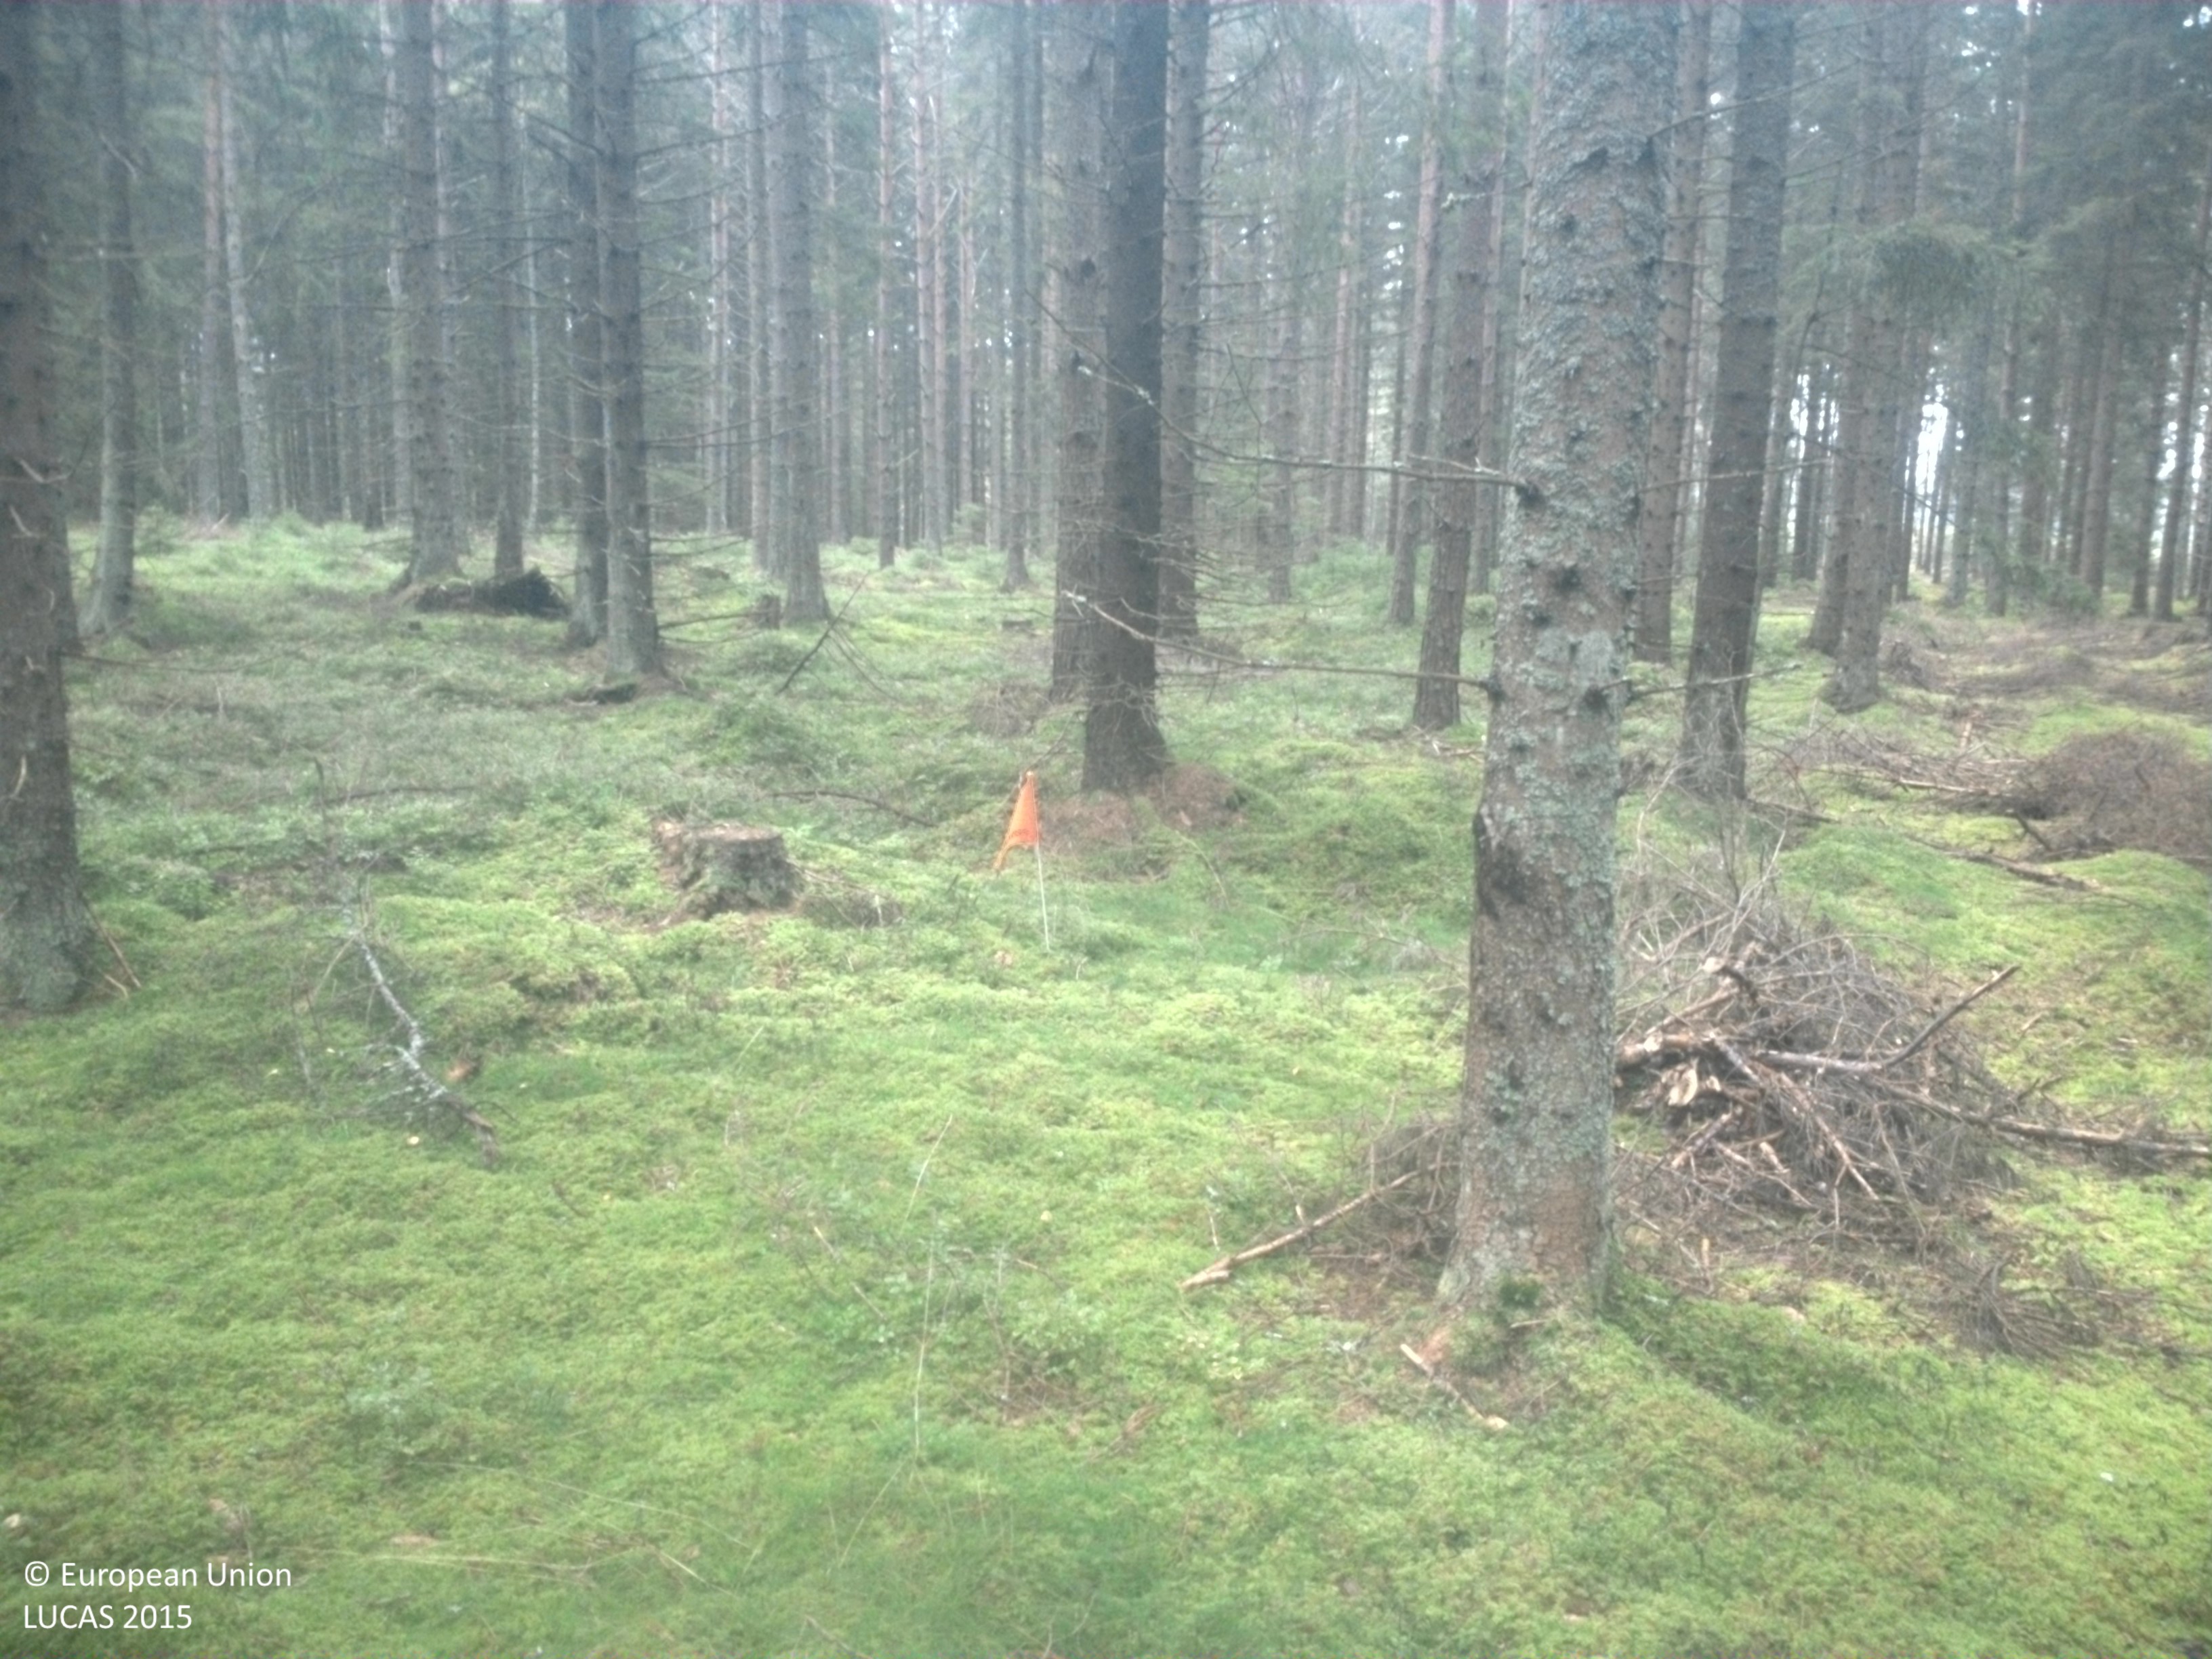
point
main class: Woodland
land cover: Spruce dominated coniferous woodland
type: boreal forest
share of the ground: 50 - 75 %
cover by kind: coniferous forest trees 60 %, lichens and mosses 25 %, shrubs 15 %
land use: Forestry
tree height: > 5 m
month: September
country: SE
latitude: 58.7718
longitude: 14.0223
